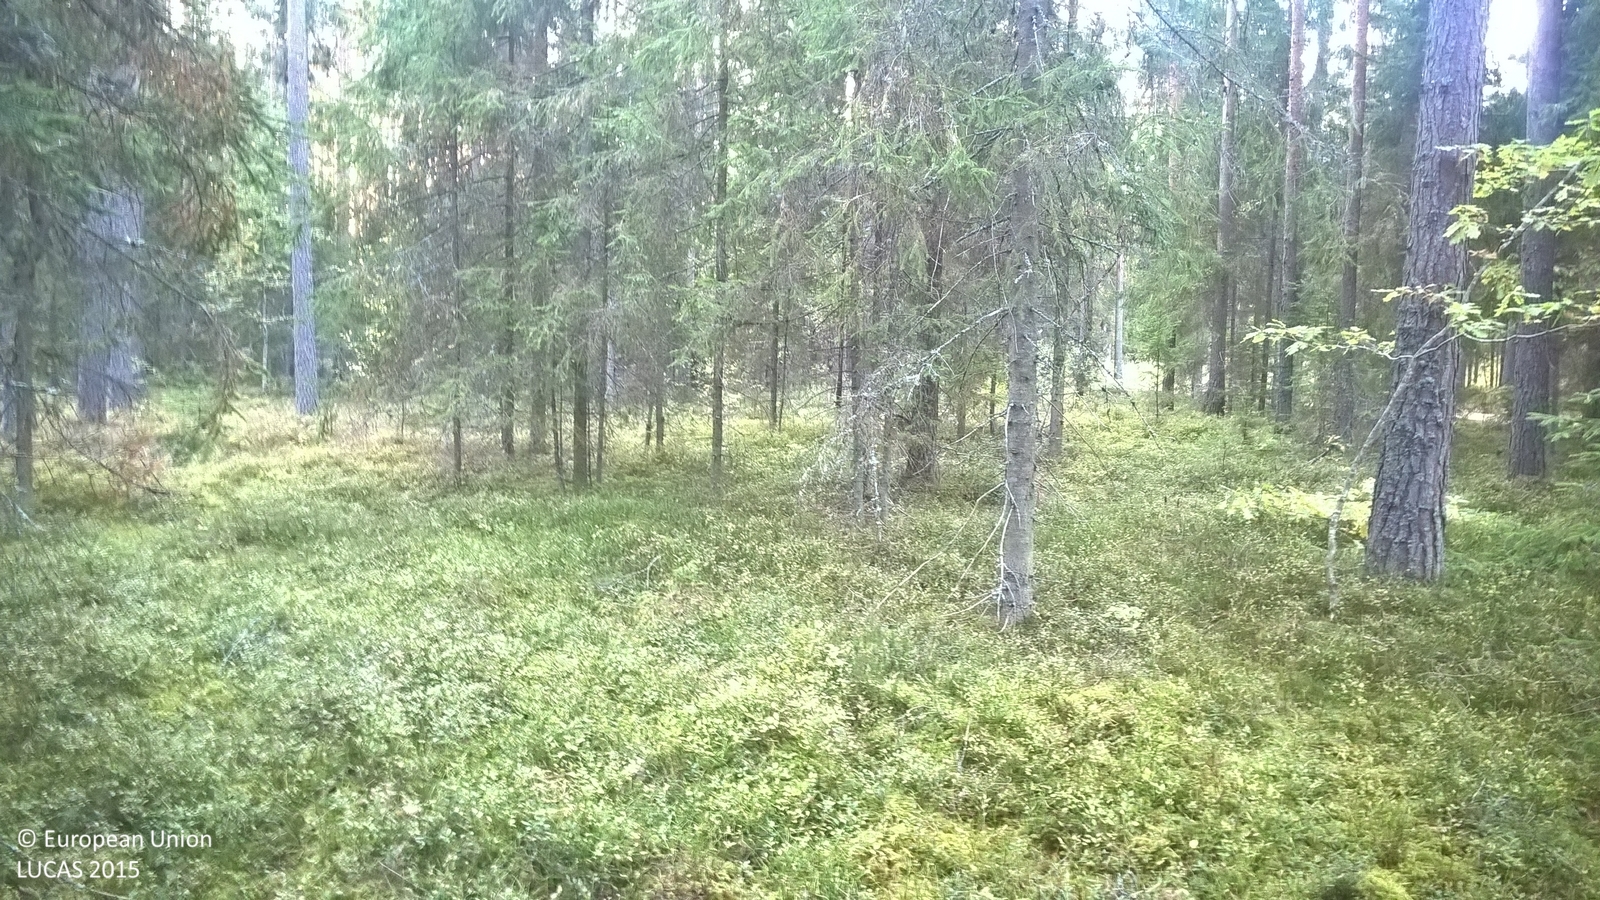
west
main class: Woodland
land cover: Other coniferous woodland
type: hemiboreal forest and nemoral coniferous forest and mixed broadleaved-coniferous forest
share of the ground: > 75 %
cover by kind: coniferous forest trees 80 %, lichens and mosses 20 %
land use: Forestry
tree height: > 5 m
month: September
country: LV
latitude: 57.6395
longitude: 25.6808
